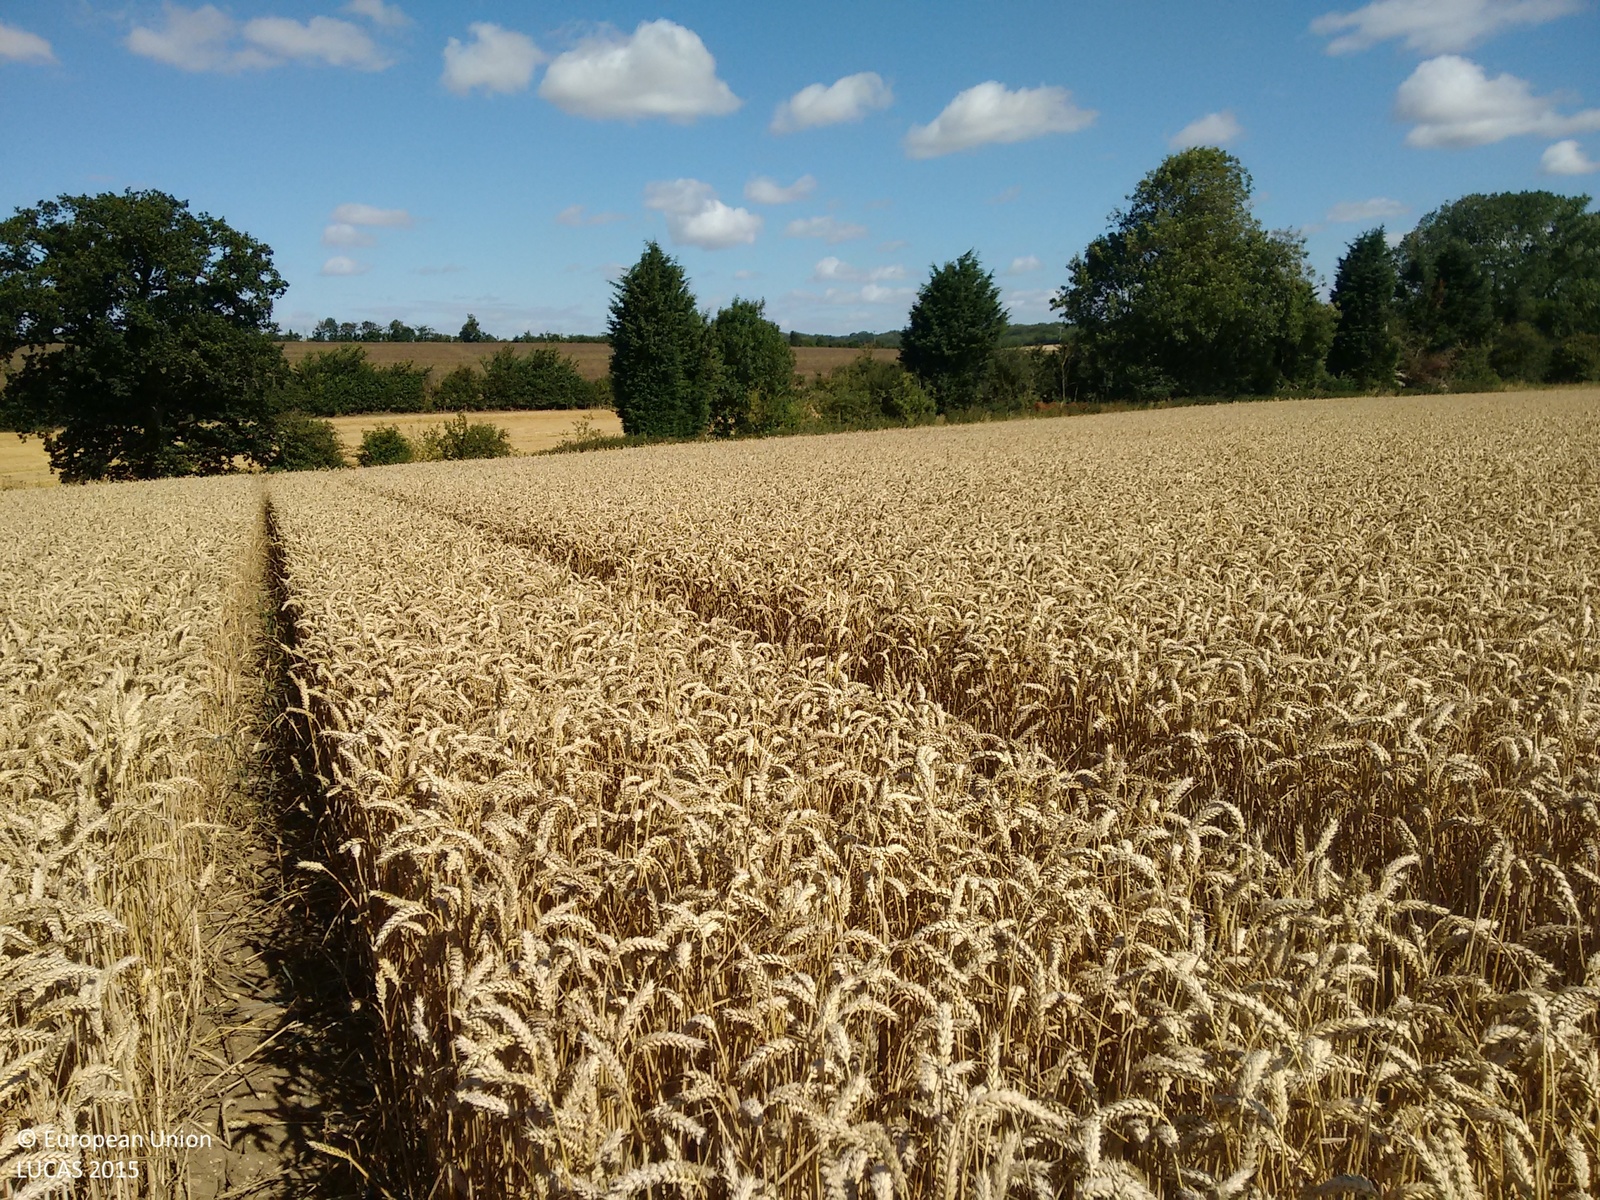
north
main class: Cropland
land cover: Common wheat
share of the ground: > 75 %
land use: Agriculture (excluding fallow land and kitchen gardens)
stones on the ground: 25 - 50 %
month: August
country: GB
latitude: 52.0947
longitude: 0.3811
